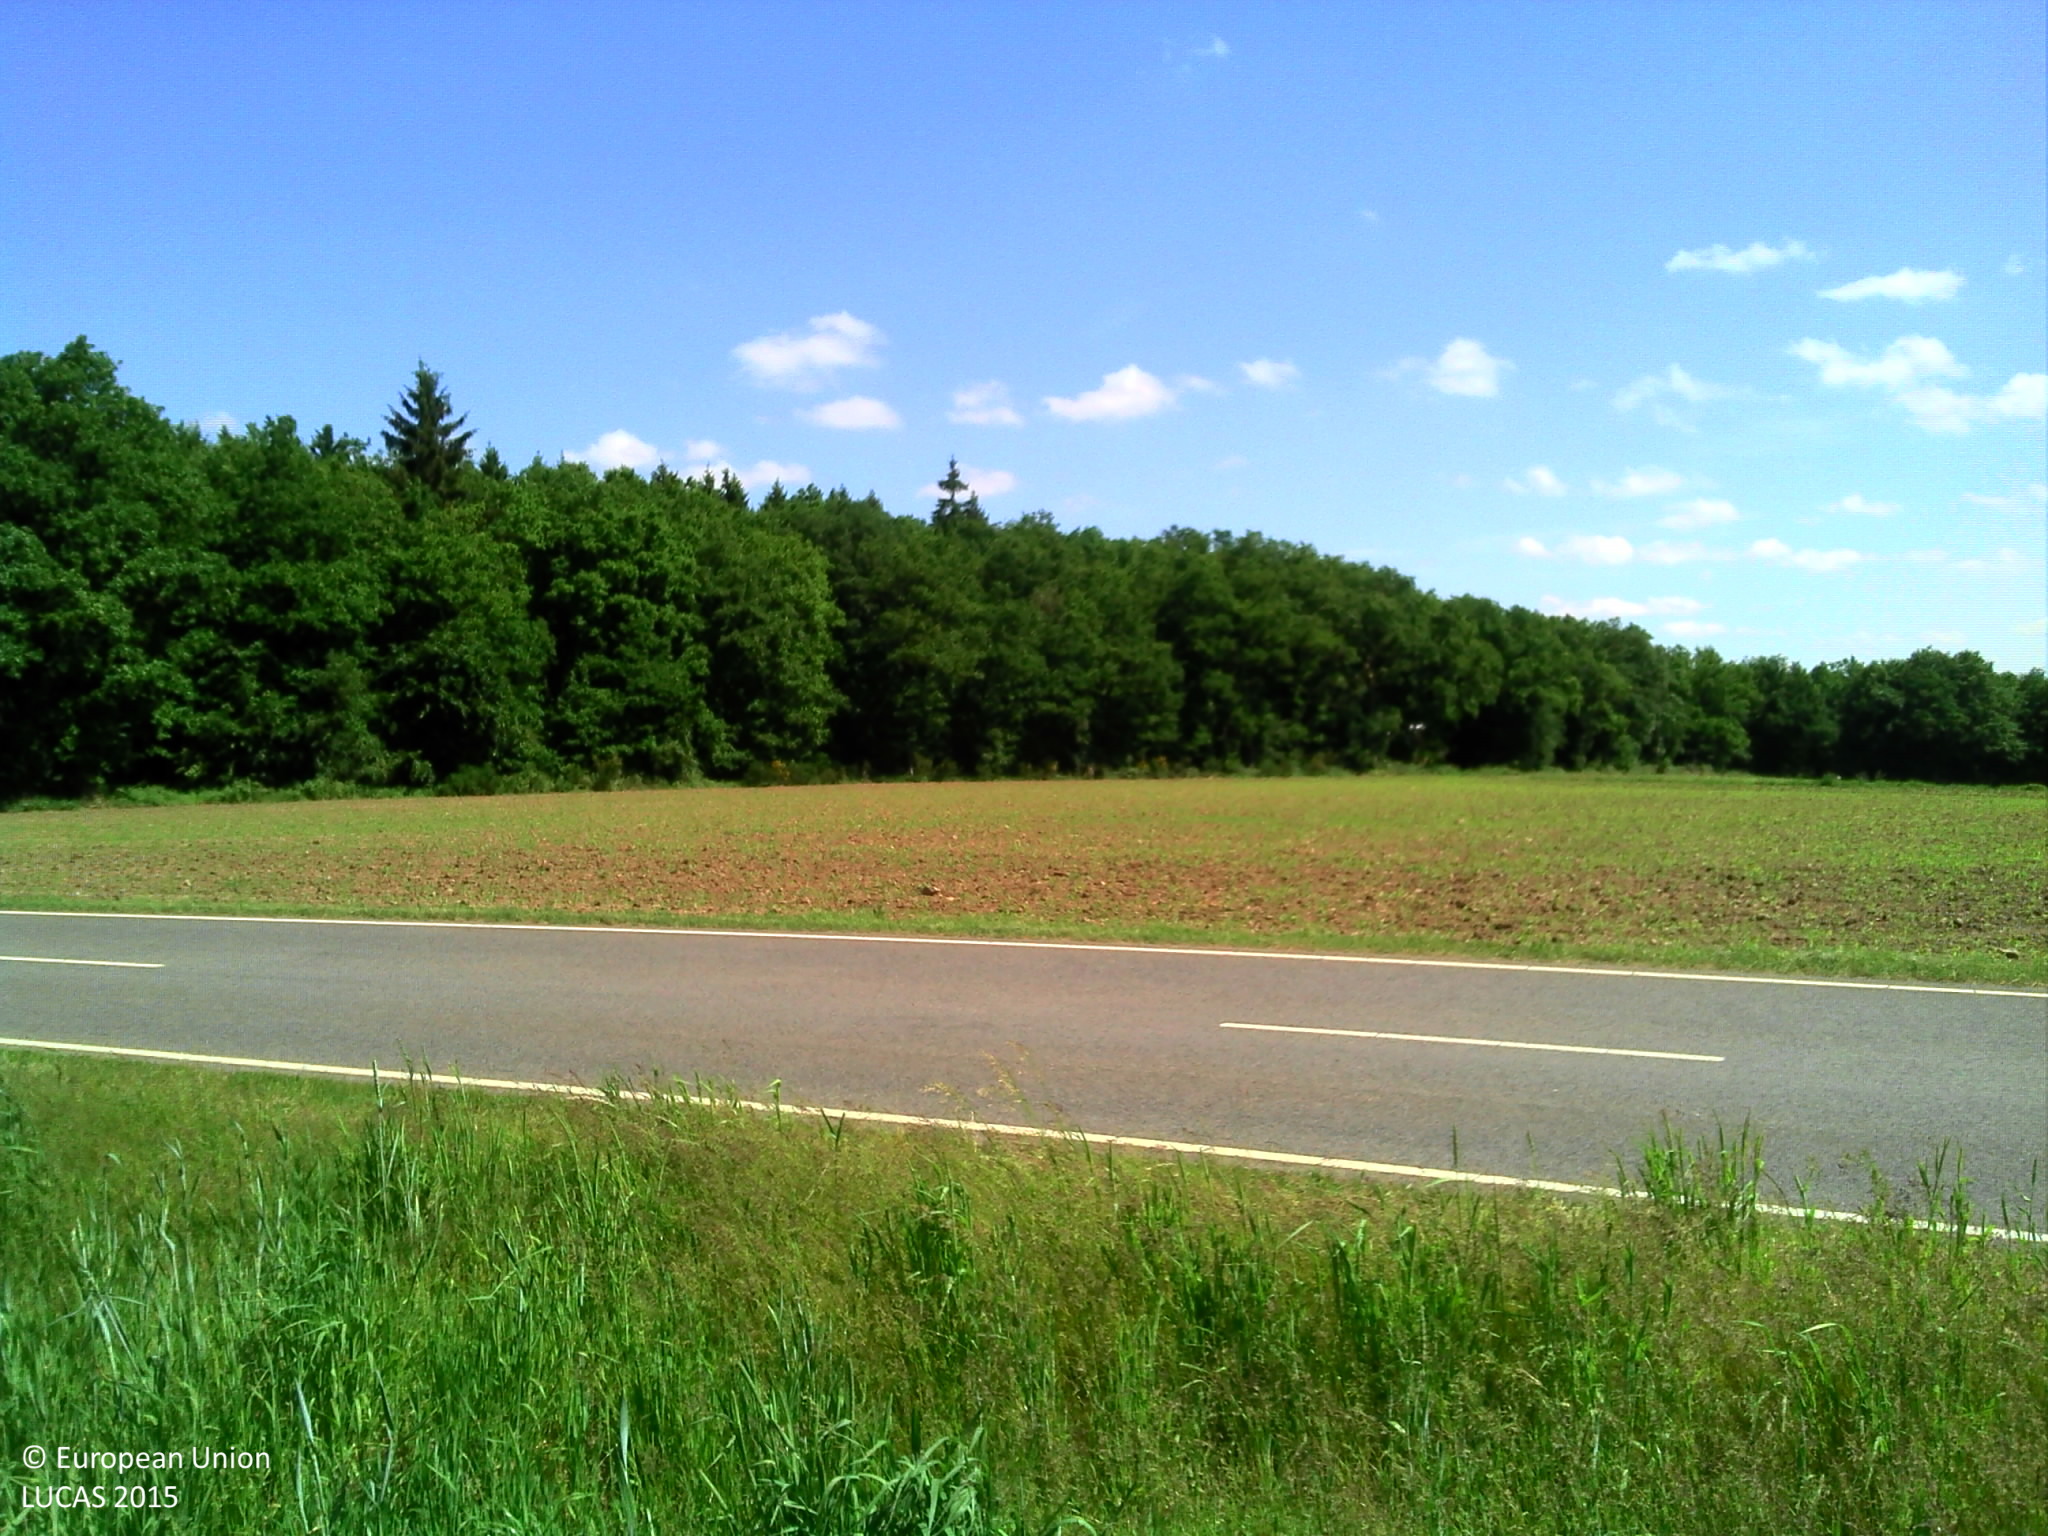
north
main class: Cropland
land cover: Common wheat
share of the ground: > 75 %
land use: Agriculture (excluding fallow land and kitchen gardens)
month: June
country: LU
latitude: 49.9091
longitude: 5.8075
